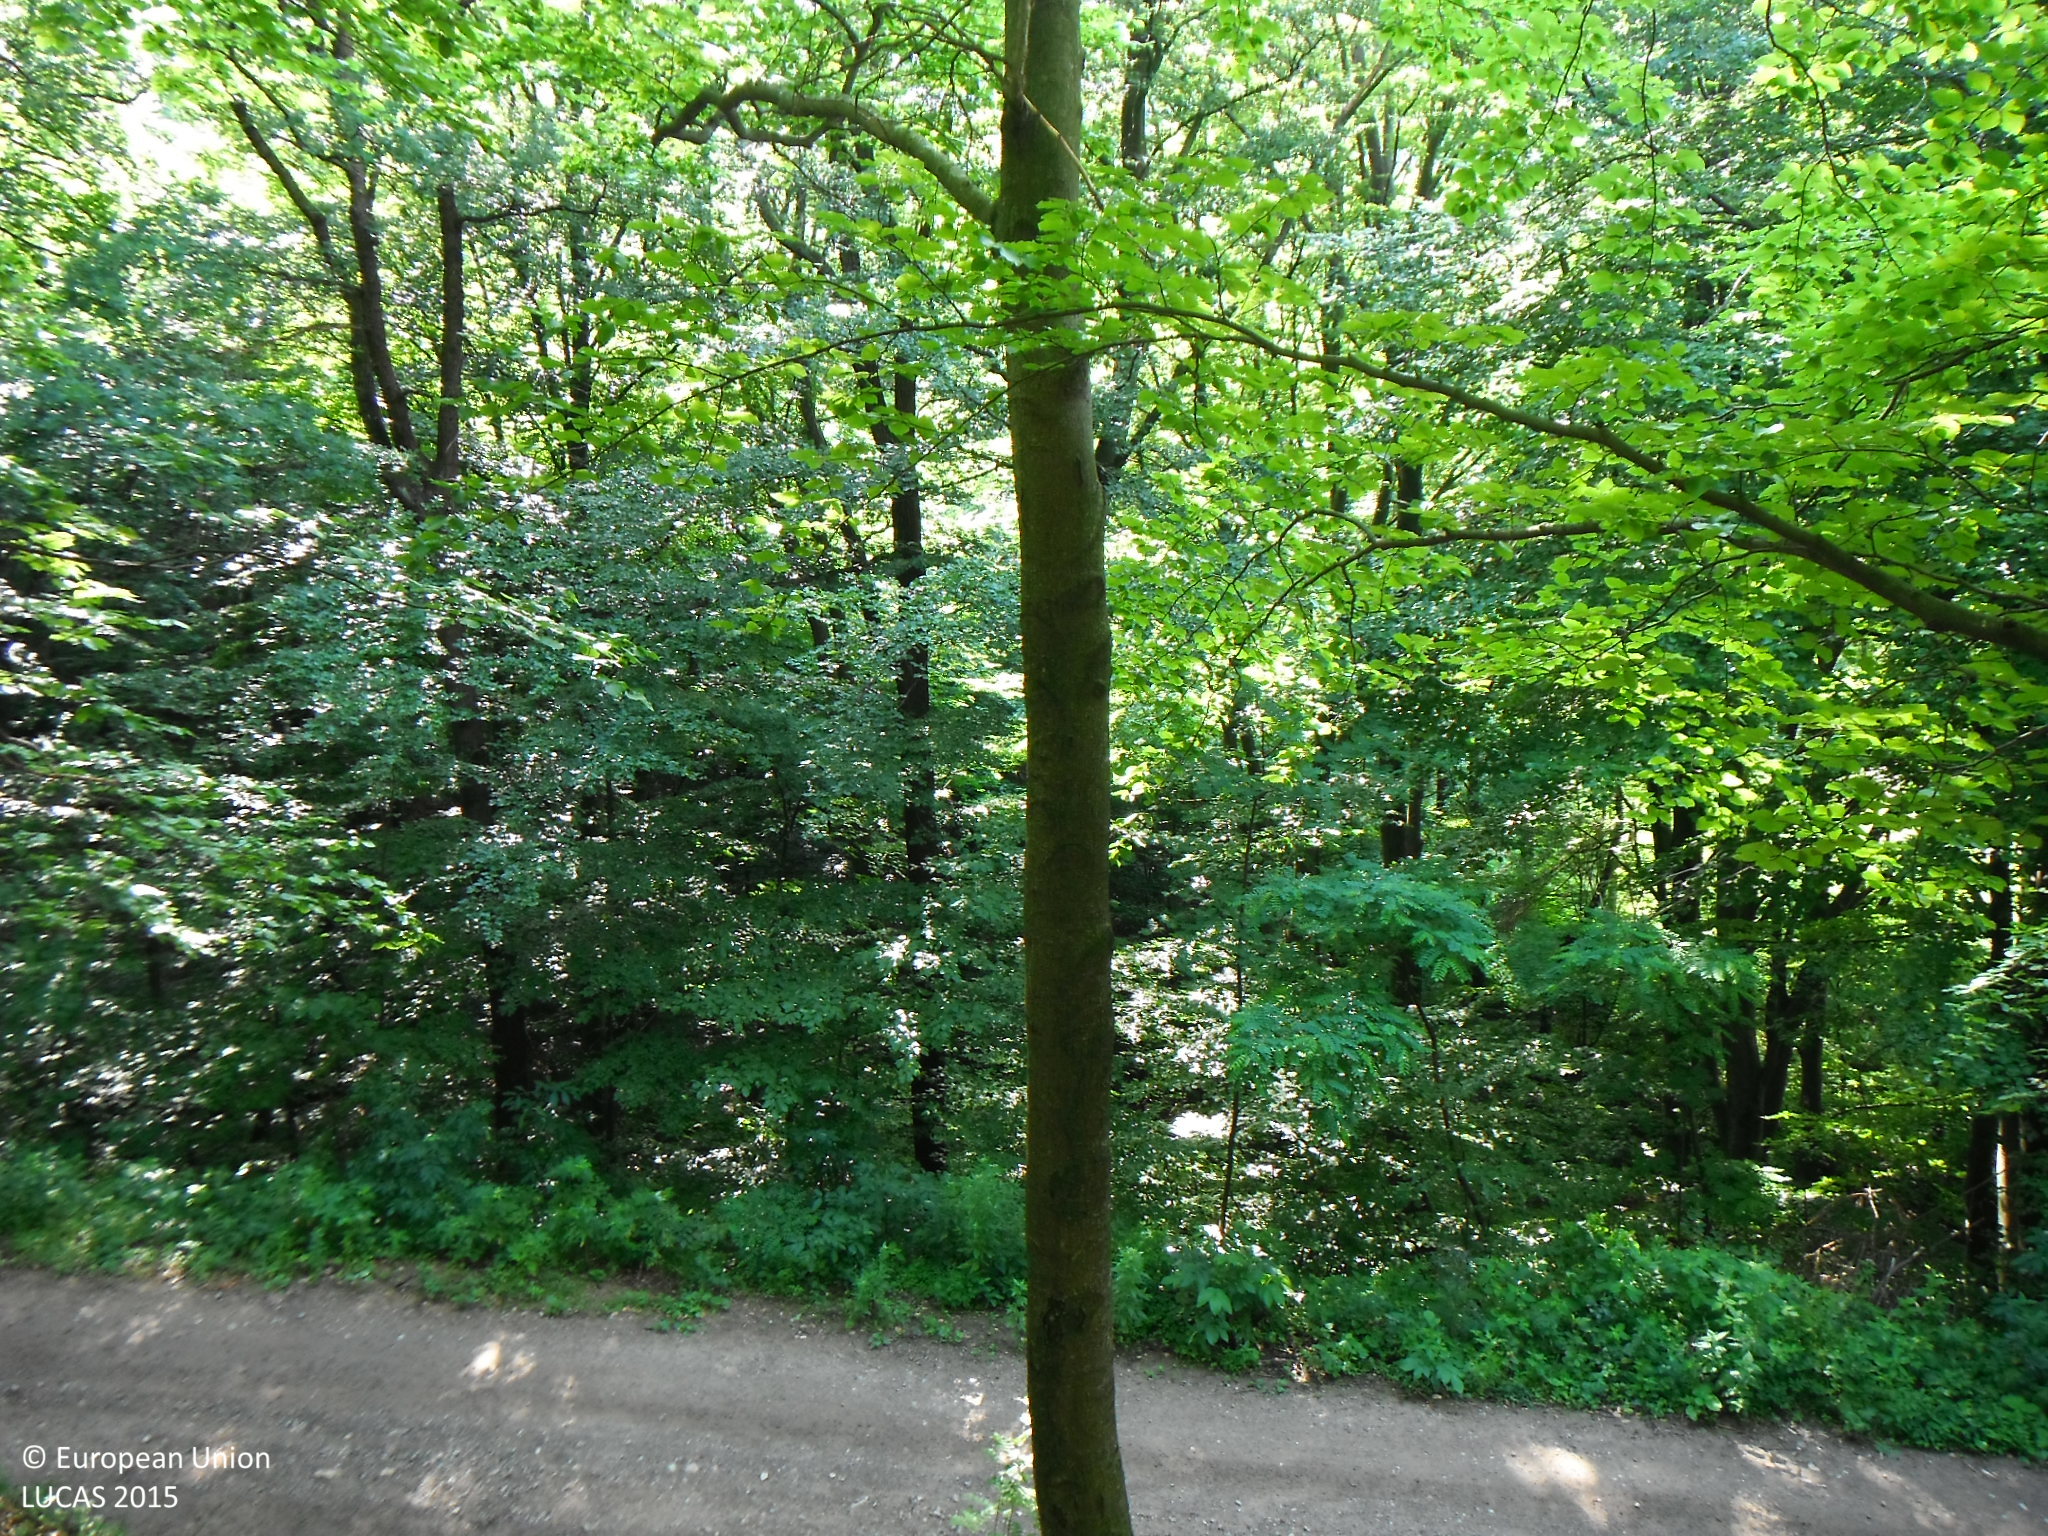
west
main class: Woodland
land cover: Broadleaved woodland
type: beech forest
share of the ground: > 75 %
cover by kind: broadleaved forest trees 85 %, shrubs 10 %, herbaceous plants 5 %
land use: Forestry
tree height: > 5 m
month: July
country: SK
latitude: 48.8136
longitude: 21.1971
